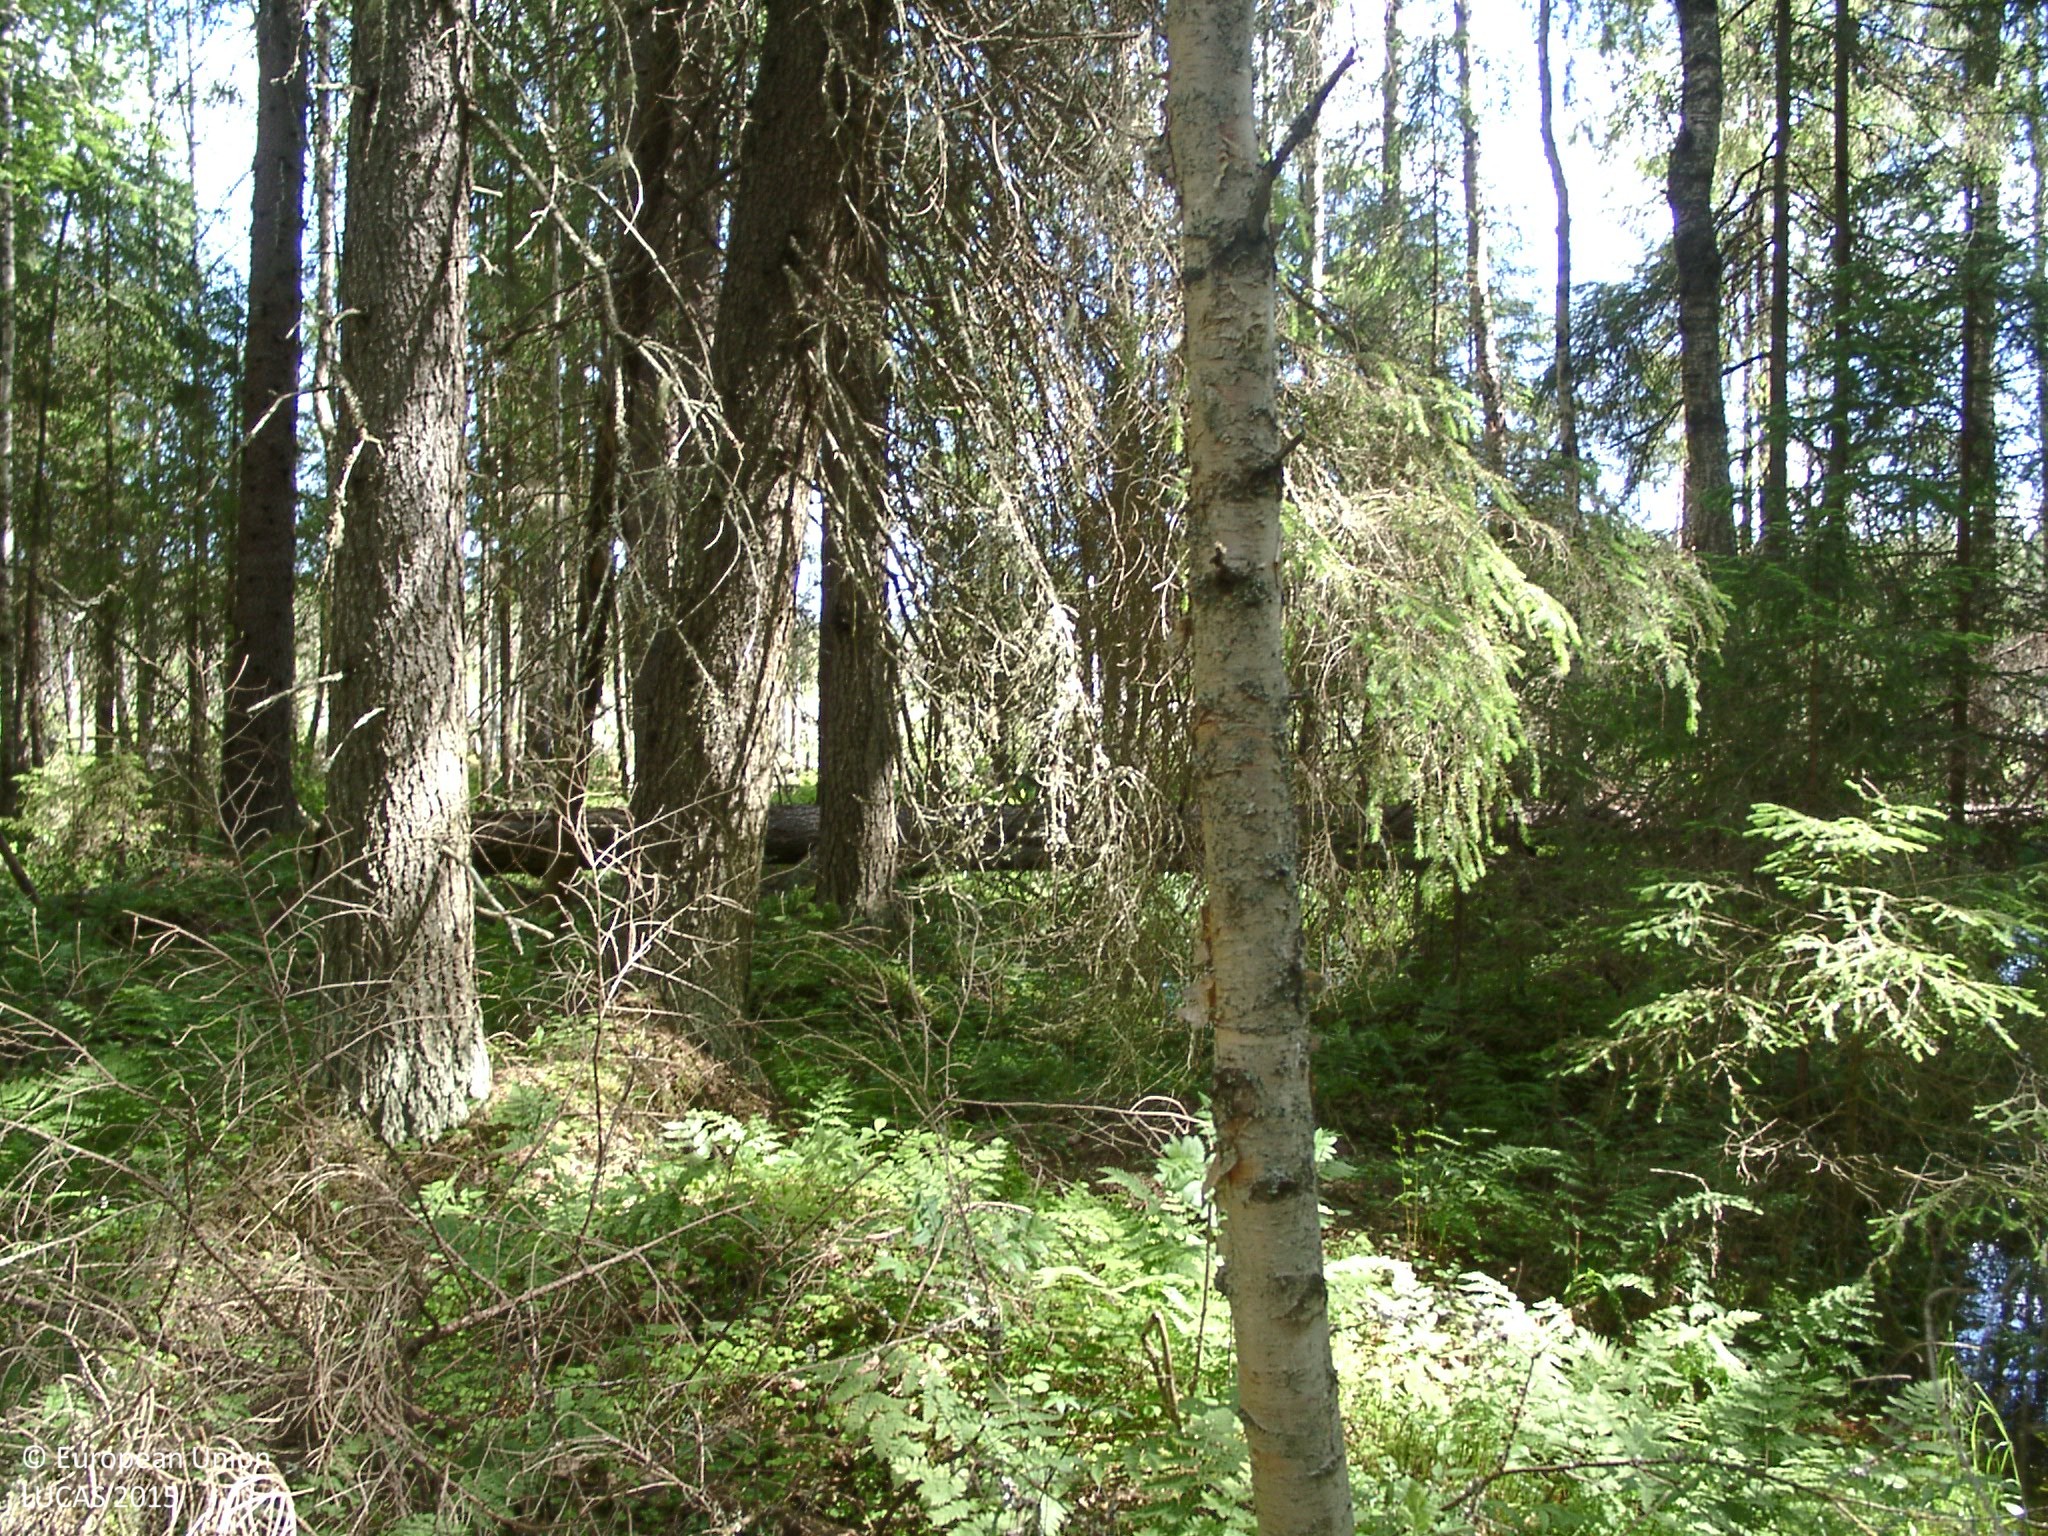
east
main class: Woodland
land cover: Other mixed woodland
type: boreal forest
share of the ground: > 75 %
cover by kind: coniferous forest trees 55 %, broadleaved forest trees 25 %, herbaceous plants 20 %
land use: Forestry
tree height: > 5 m
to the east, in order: Other mixed woodland; Rivers and streams; Other mixed woodland; Ditches and canals; Other mixed woodland; Shrubland with sparse tree cover; Ditches and canals; Shrubland with sparse tree cover; Ditches and canals; Shrubland with sparse tree cover; Ditches and canals; Shrubland with sparse tree cover; Ditches and canals; Other bare soil; Ditches and canals; Other bare soil
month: June
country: FI
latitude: 62.0817
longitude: 24.9403
